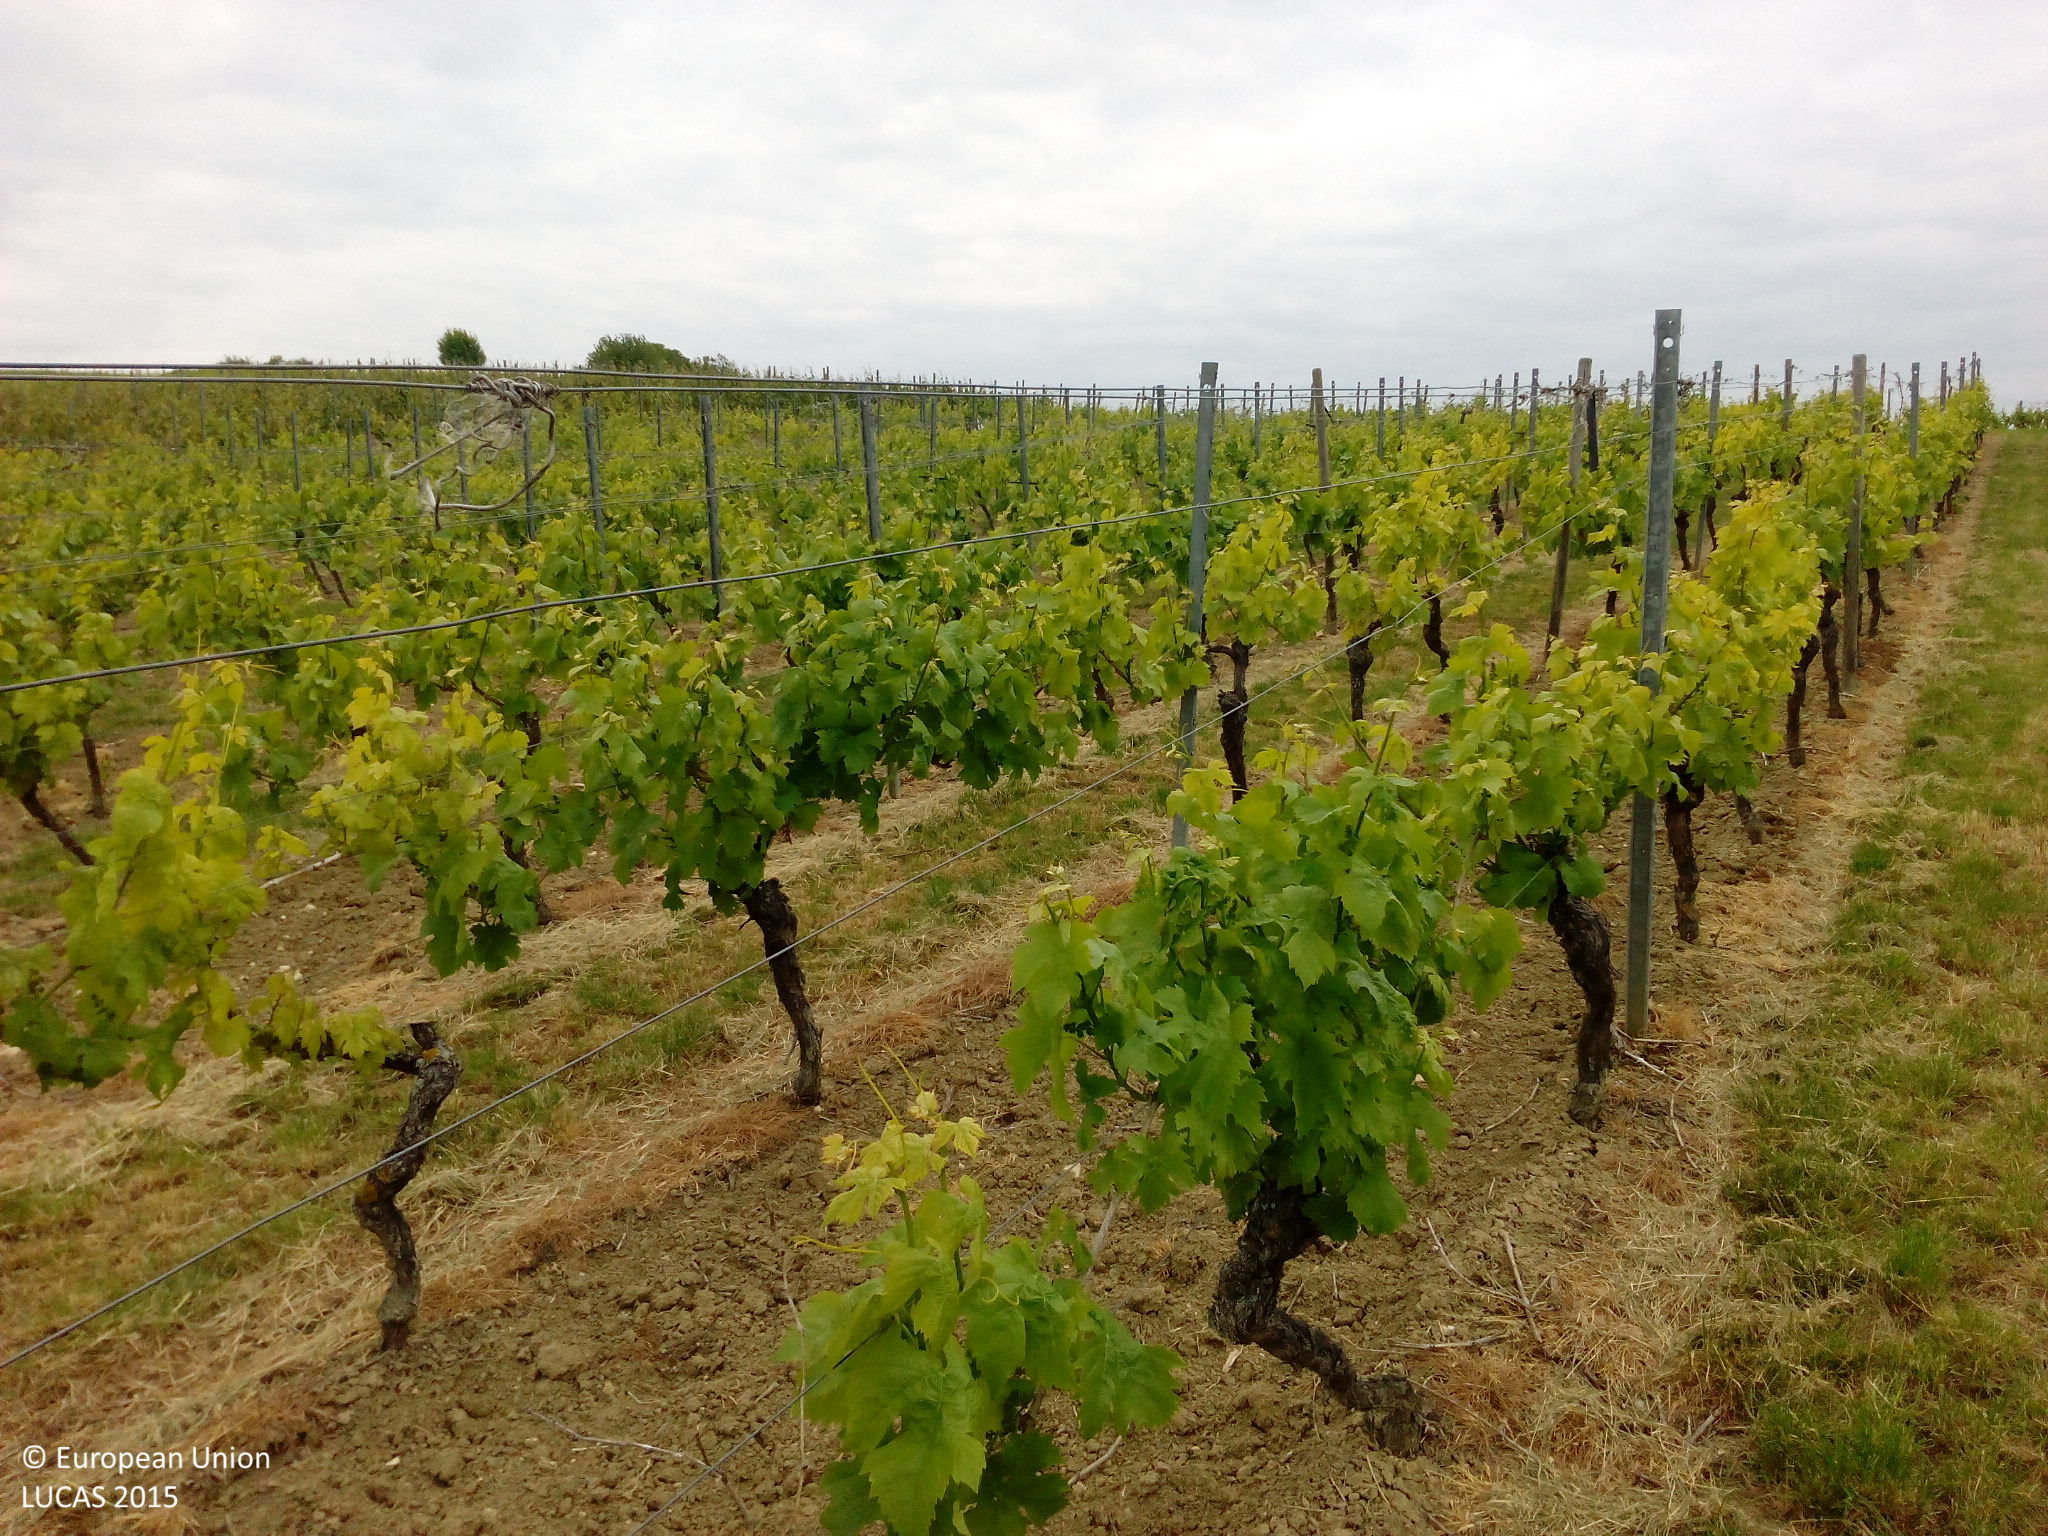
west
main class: Cropland
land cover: Vineyards
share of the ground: 50 - 75 %
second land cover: Grassland without tree/shrub cover
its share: 50 - 75 %
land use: Agriculture (excluding fallow land and kitchen gardens)
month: May
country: DE
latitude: 49.8616
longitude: 8.0390
